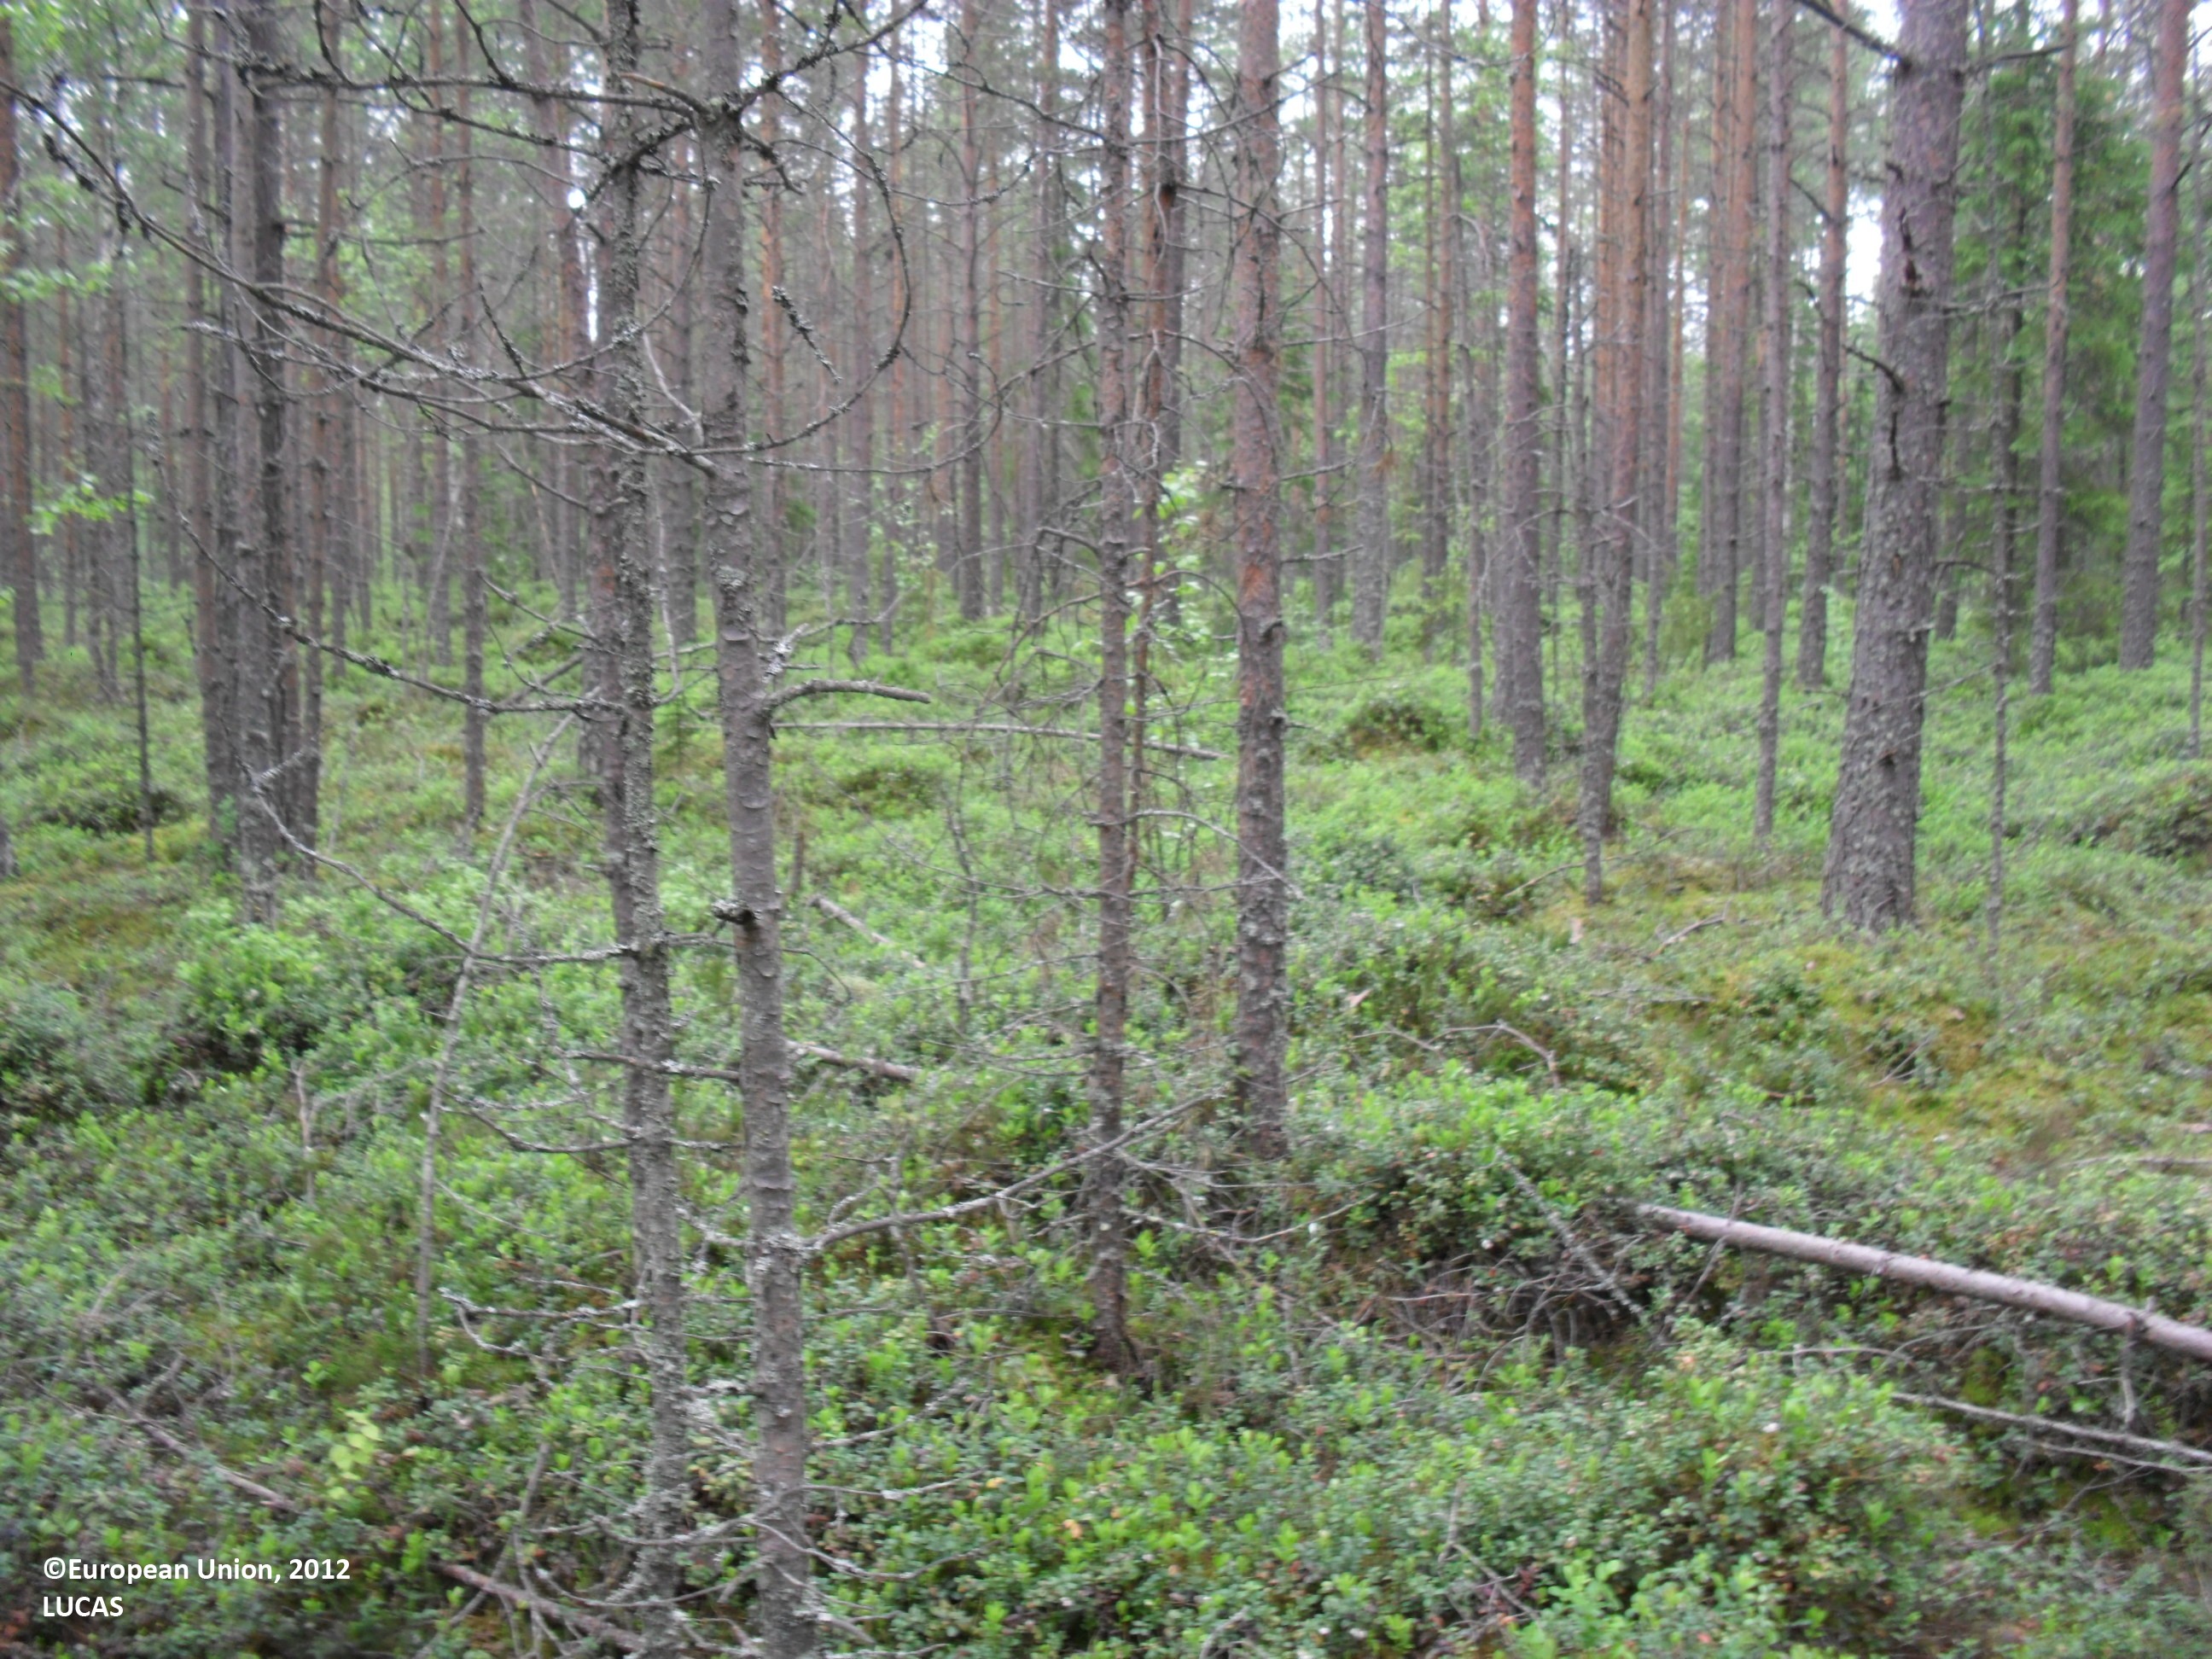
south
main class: Woodland
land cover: Pine dominated coniferous woodland
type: boreal forest
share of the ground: 50 - 75 %
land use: Forestry
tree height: > 5 m
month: June
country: FI
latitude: 63.1947
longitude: 23.2788
